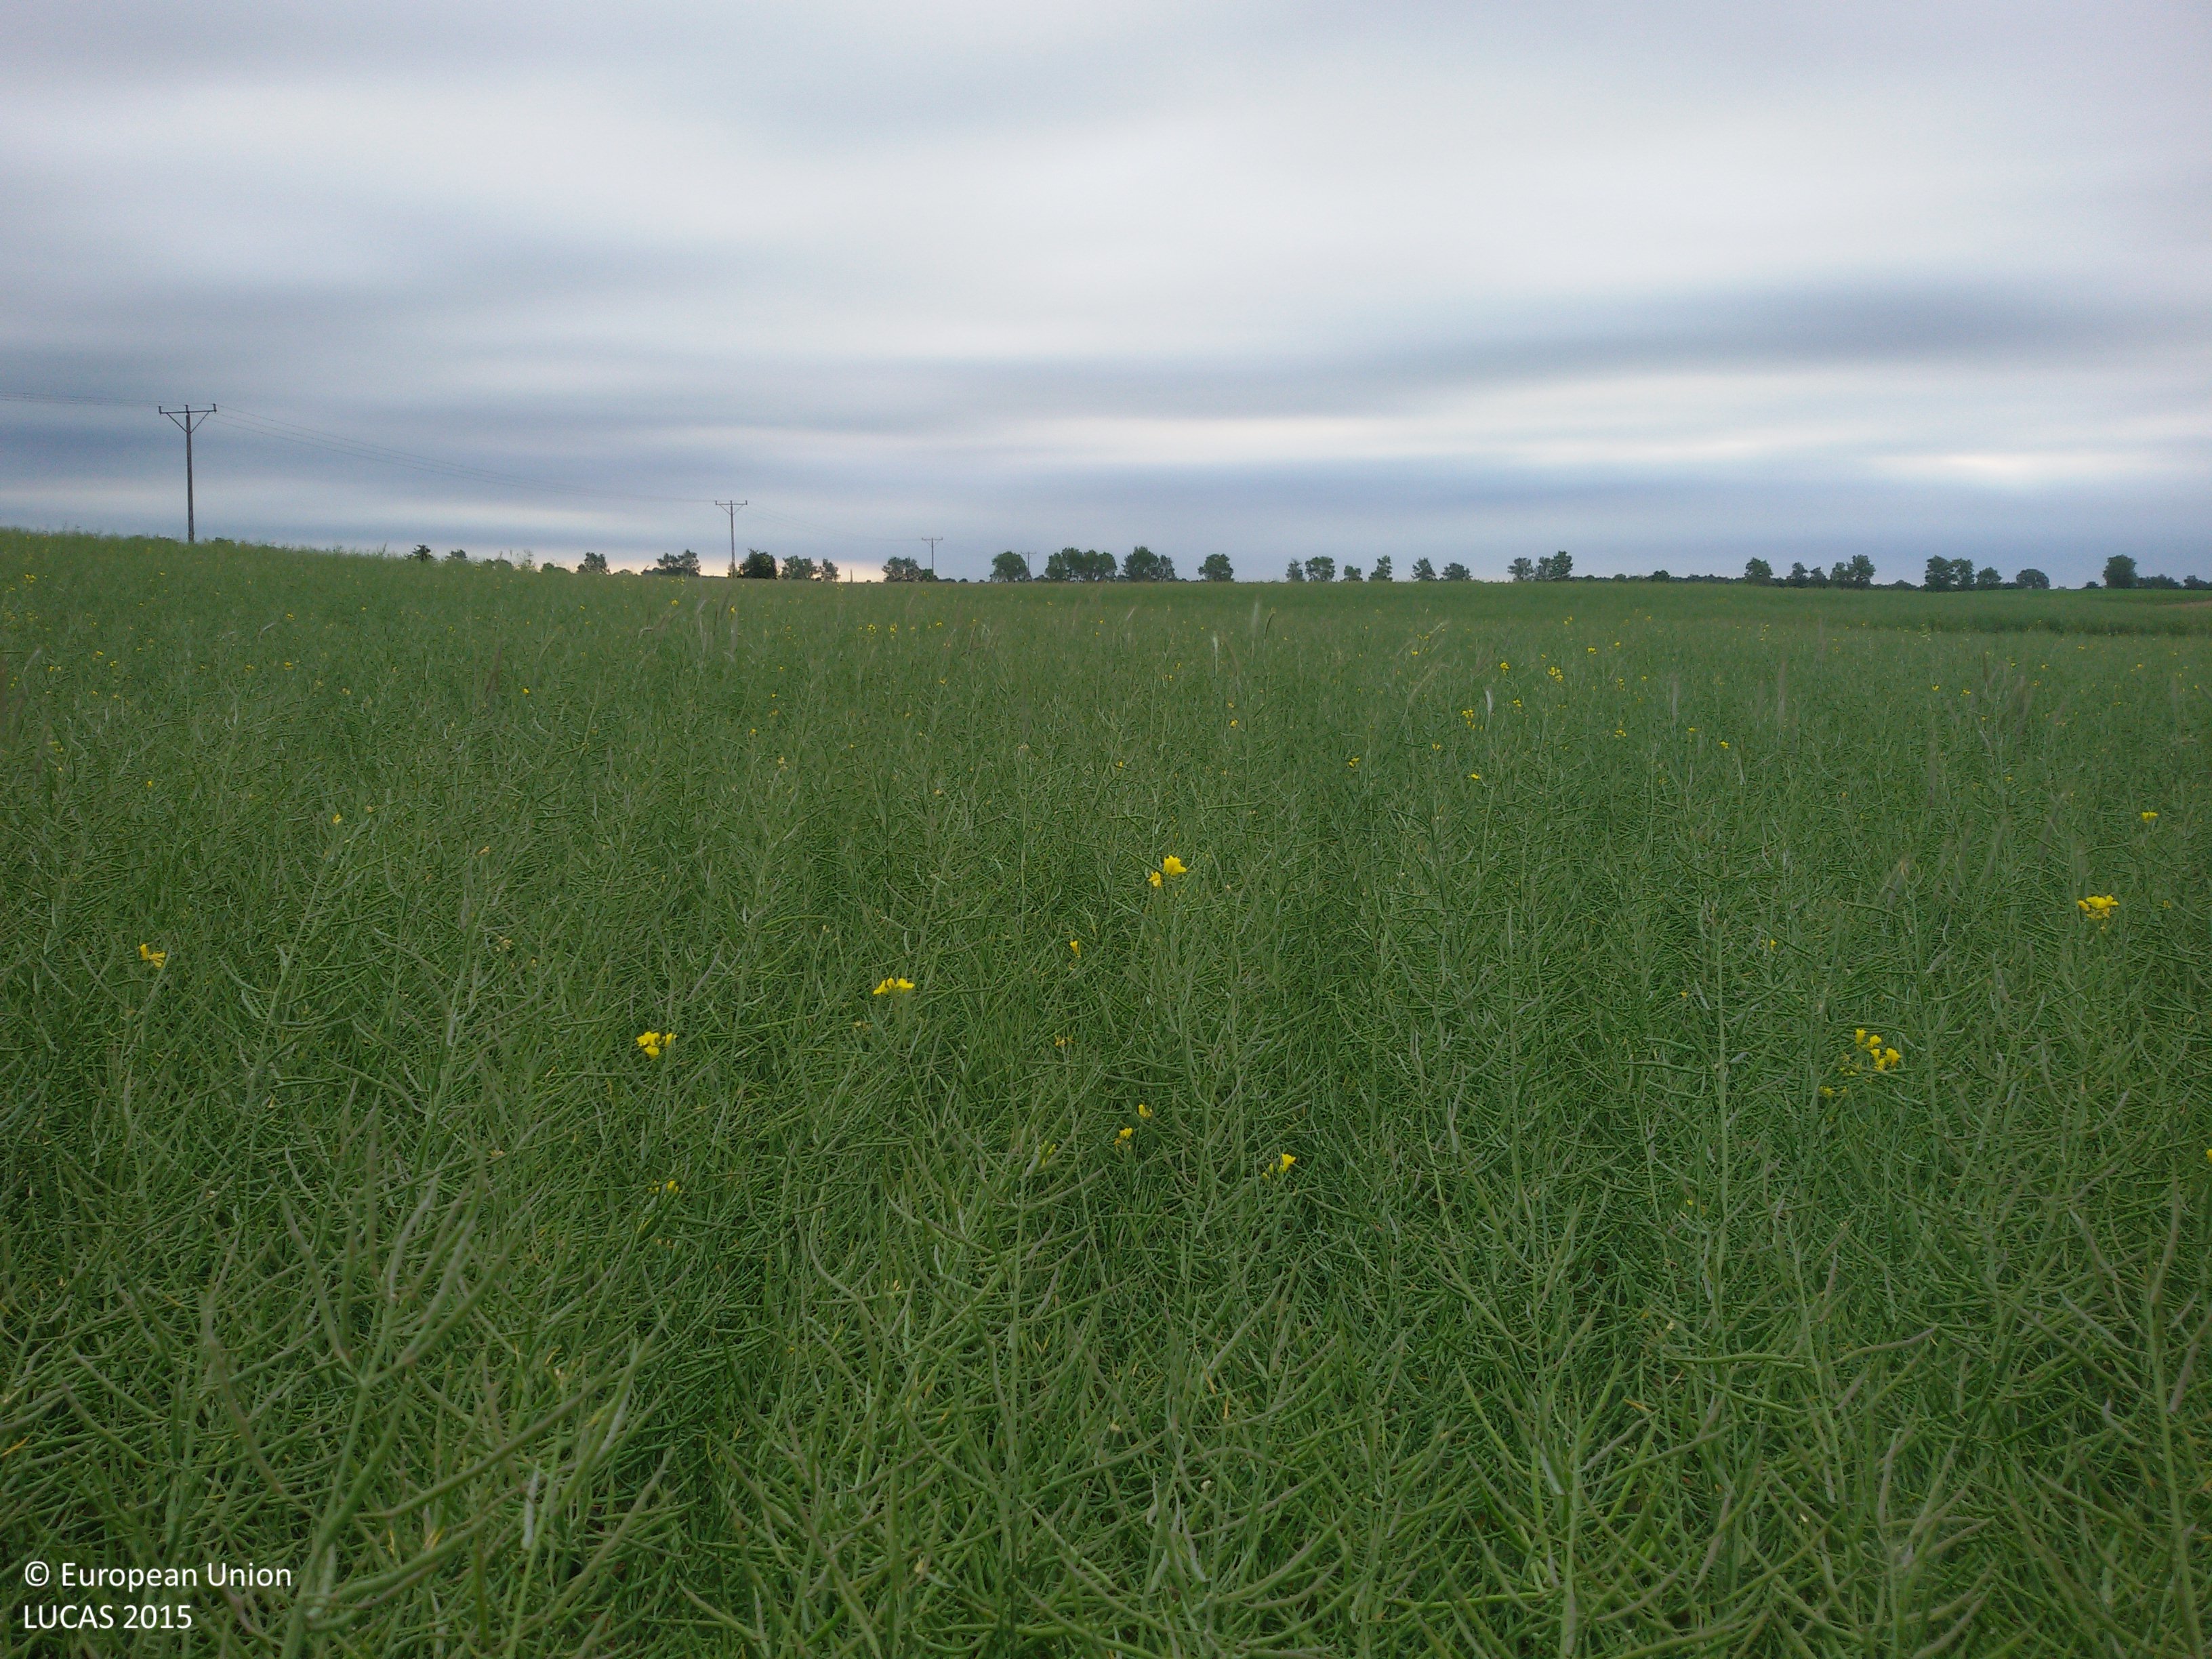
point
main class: Cropland
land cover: Rape and turnip rape
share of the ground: > 75 %
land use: Agriculture (excluding fallow land and kitchen gardens)
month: June
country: PL
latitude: 53.2112
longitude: 17.6947
